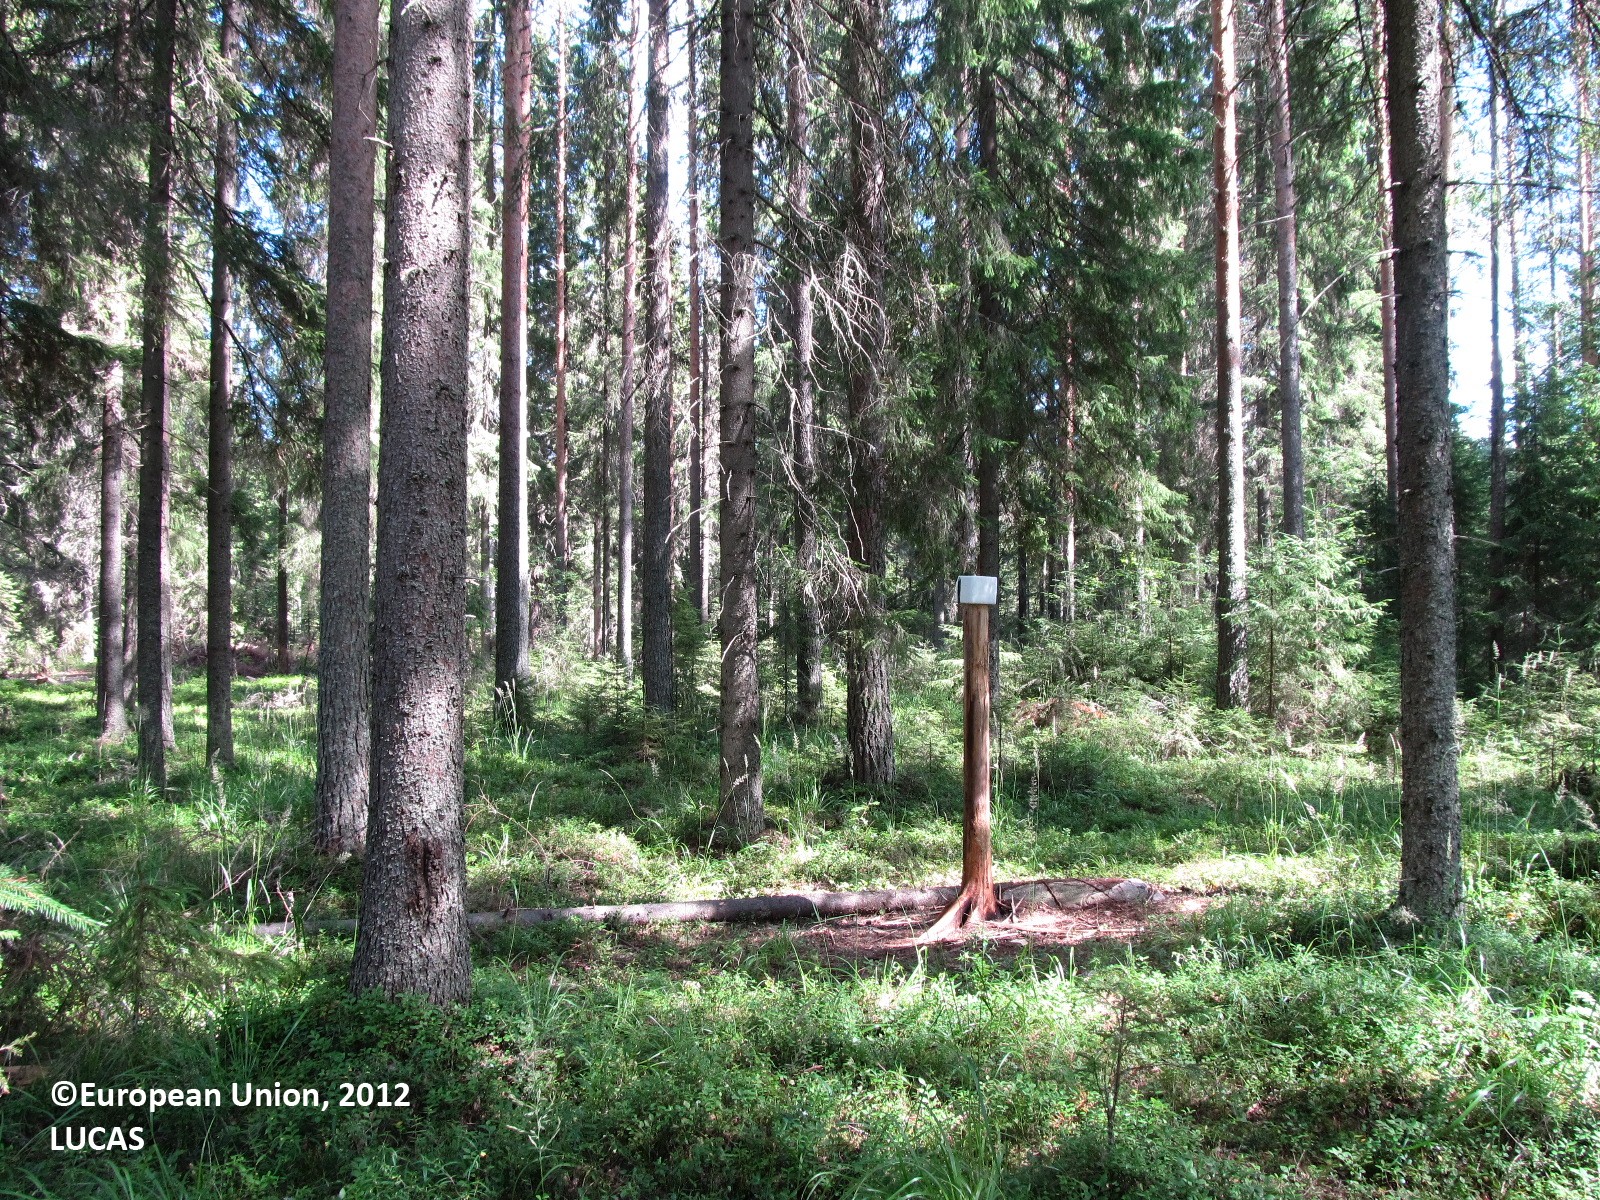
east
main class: Woodland
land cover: Spruce dominated coniferous woodland
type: boreal forest
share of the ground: 50 - 75 %
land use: Forestry
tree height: > 5 m
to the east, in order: Spruce dominated coniferous woodland; Paved roads, cycling and walking lanes; Spruce dominated coniferous woodland; Spruce dominated mixed woodland; Ditches and canals; Spruce dominated coniferous woodland; Ditches and canals; Spruce dominated coniferous woodland
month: July
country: FI
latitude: 61.9482
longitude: 27.9336
